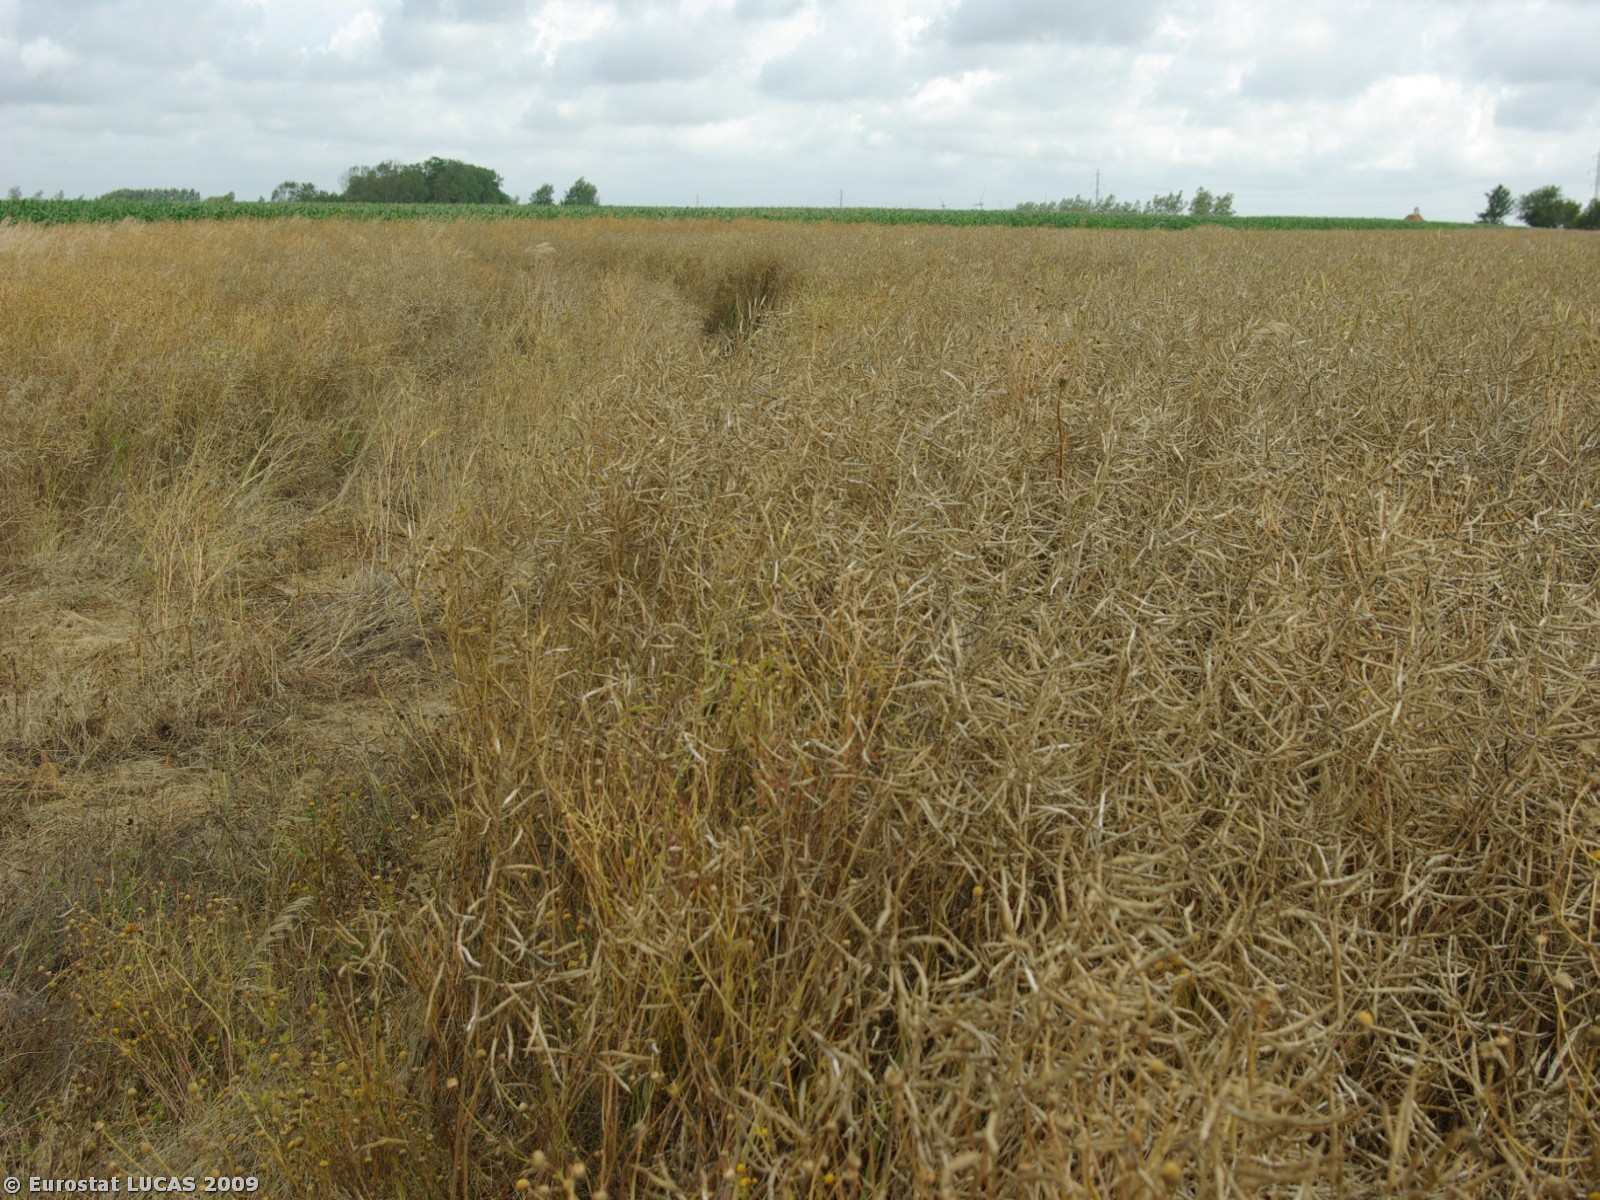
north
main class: Cropland
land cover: Rape and turnip rape
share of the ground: > 75 %
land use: Agriculture (excluding fallow land and kitchen gardens)
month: July
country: DK
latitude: 54.9606
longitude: 8.8920
